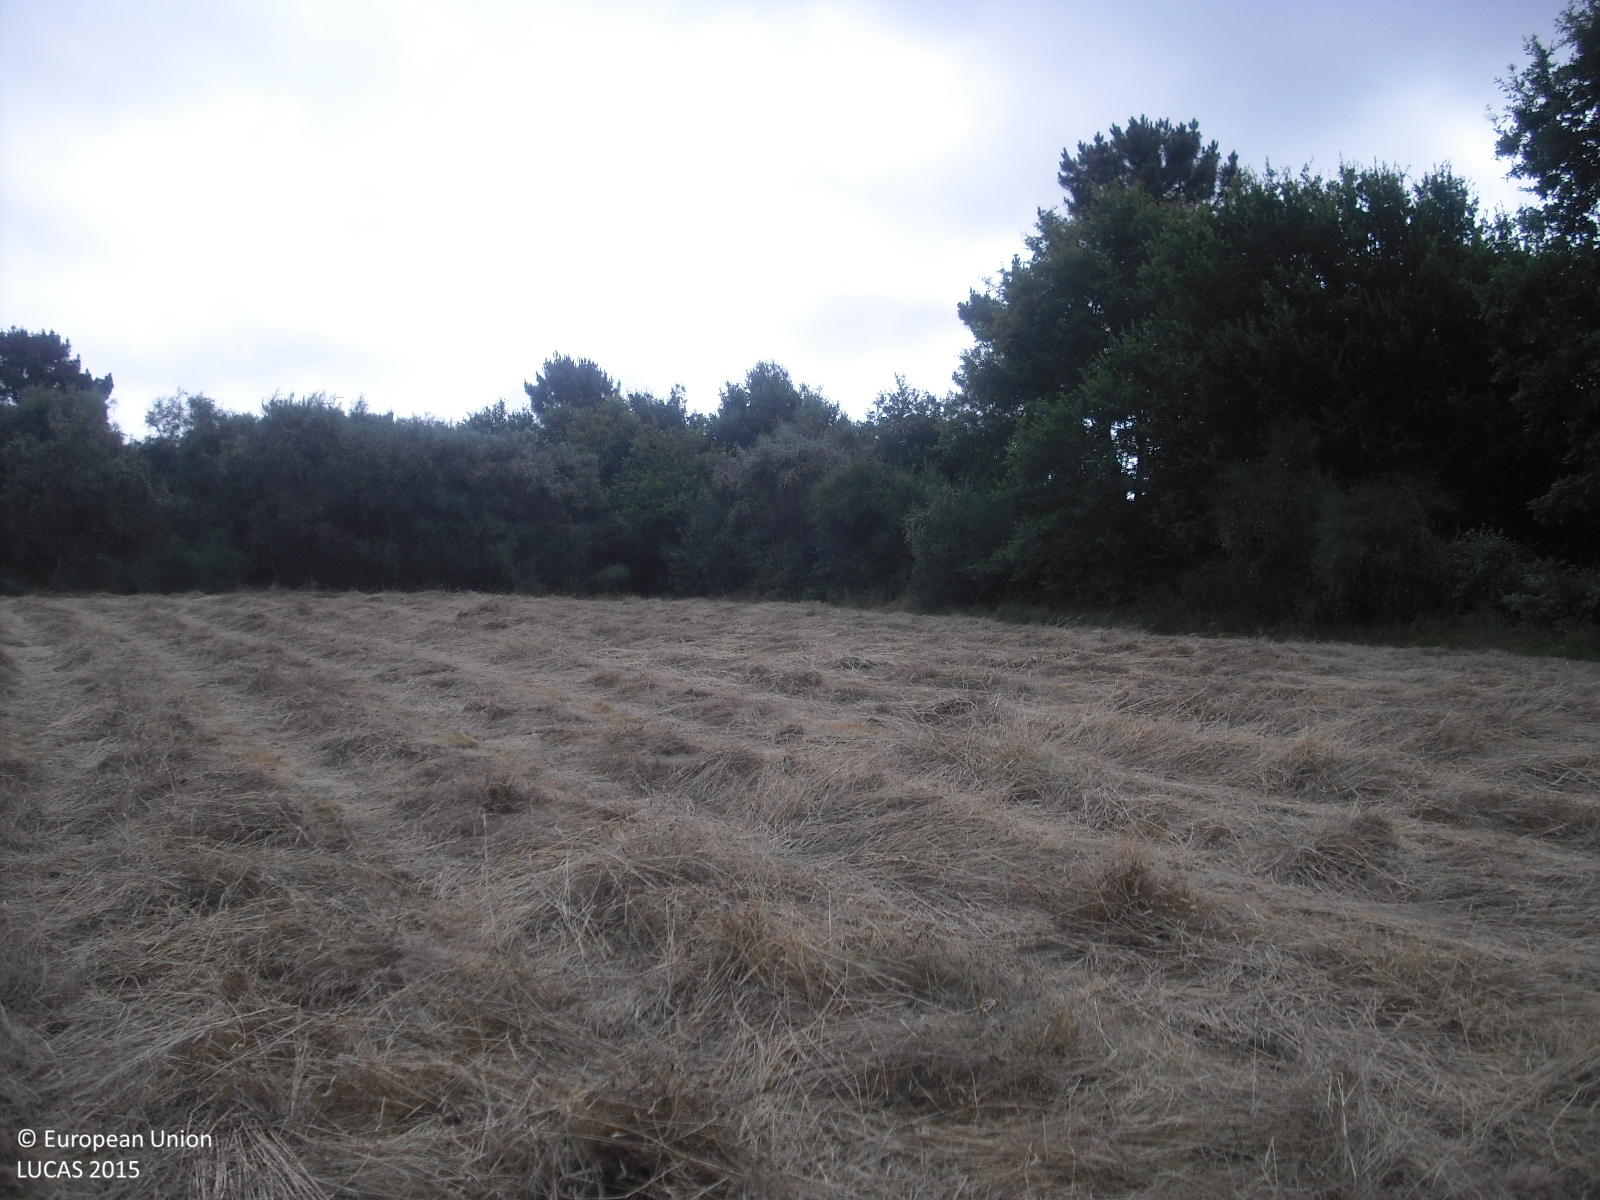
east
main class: Grassland
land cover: Grassland without tree/shrub cover
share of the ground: > 75 %
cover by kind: herbaceous plants 100 %
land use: Agriculture (excluding fallow land and kitchen gardens)
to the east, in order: Grassland without tree/shrub cover; Shrubland without tree cover; Broadleaved woodland; Shrubland with sparse tree cover; Broadleaved woodland; Grassland without tree/shrub cover; Rivers and streams; Grassland without tree/shrub cover; Broadleaved woodland
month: July
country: ES
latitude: 42.4686
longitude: -7.6725
